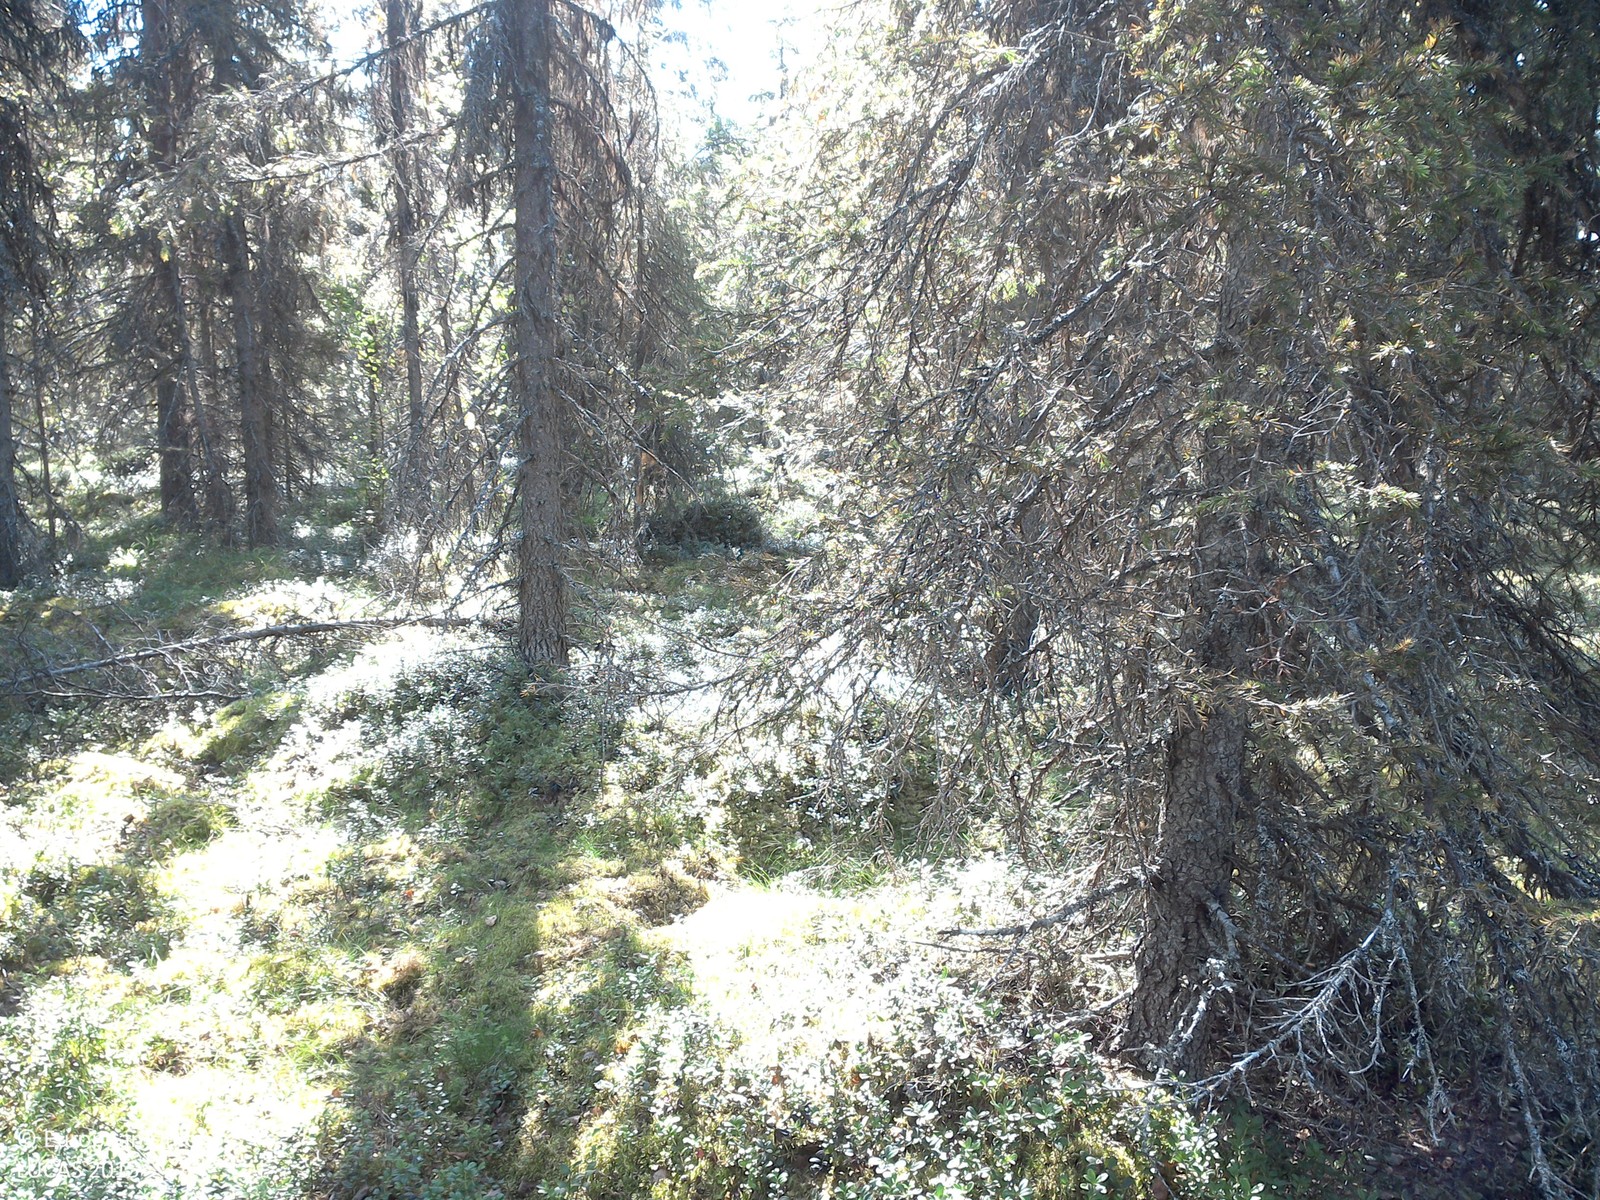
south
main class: Woodland
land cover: Spruce dominated mixed woodland
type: boreal forest
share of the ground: 25 - 50 %
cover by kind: shrubs 50 %, coniferous forest trees 25 %, lichens and mosses 15 %, broadleaved forest trees 10 %
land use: Forestry
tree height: > 5 m
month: August
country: SE
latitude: 67.0953
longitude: 22.0009
